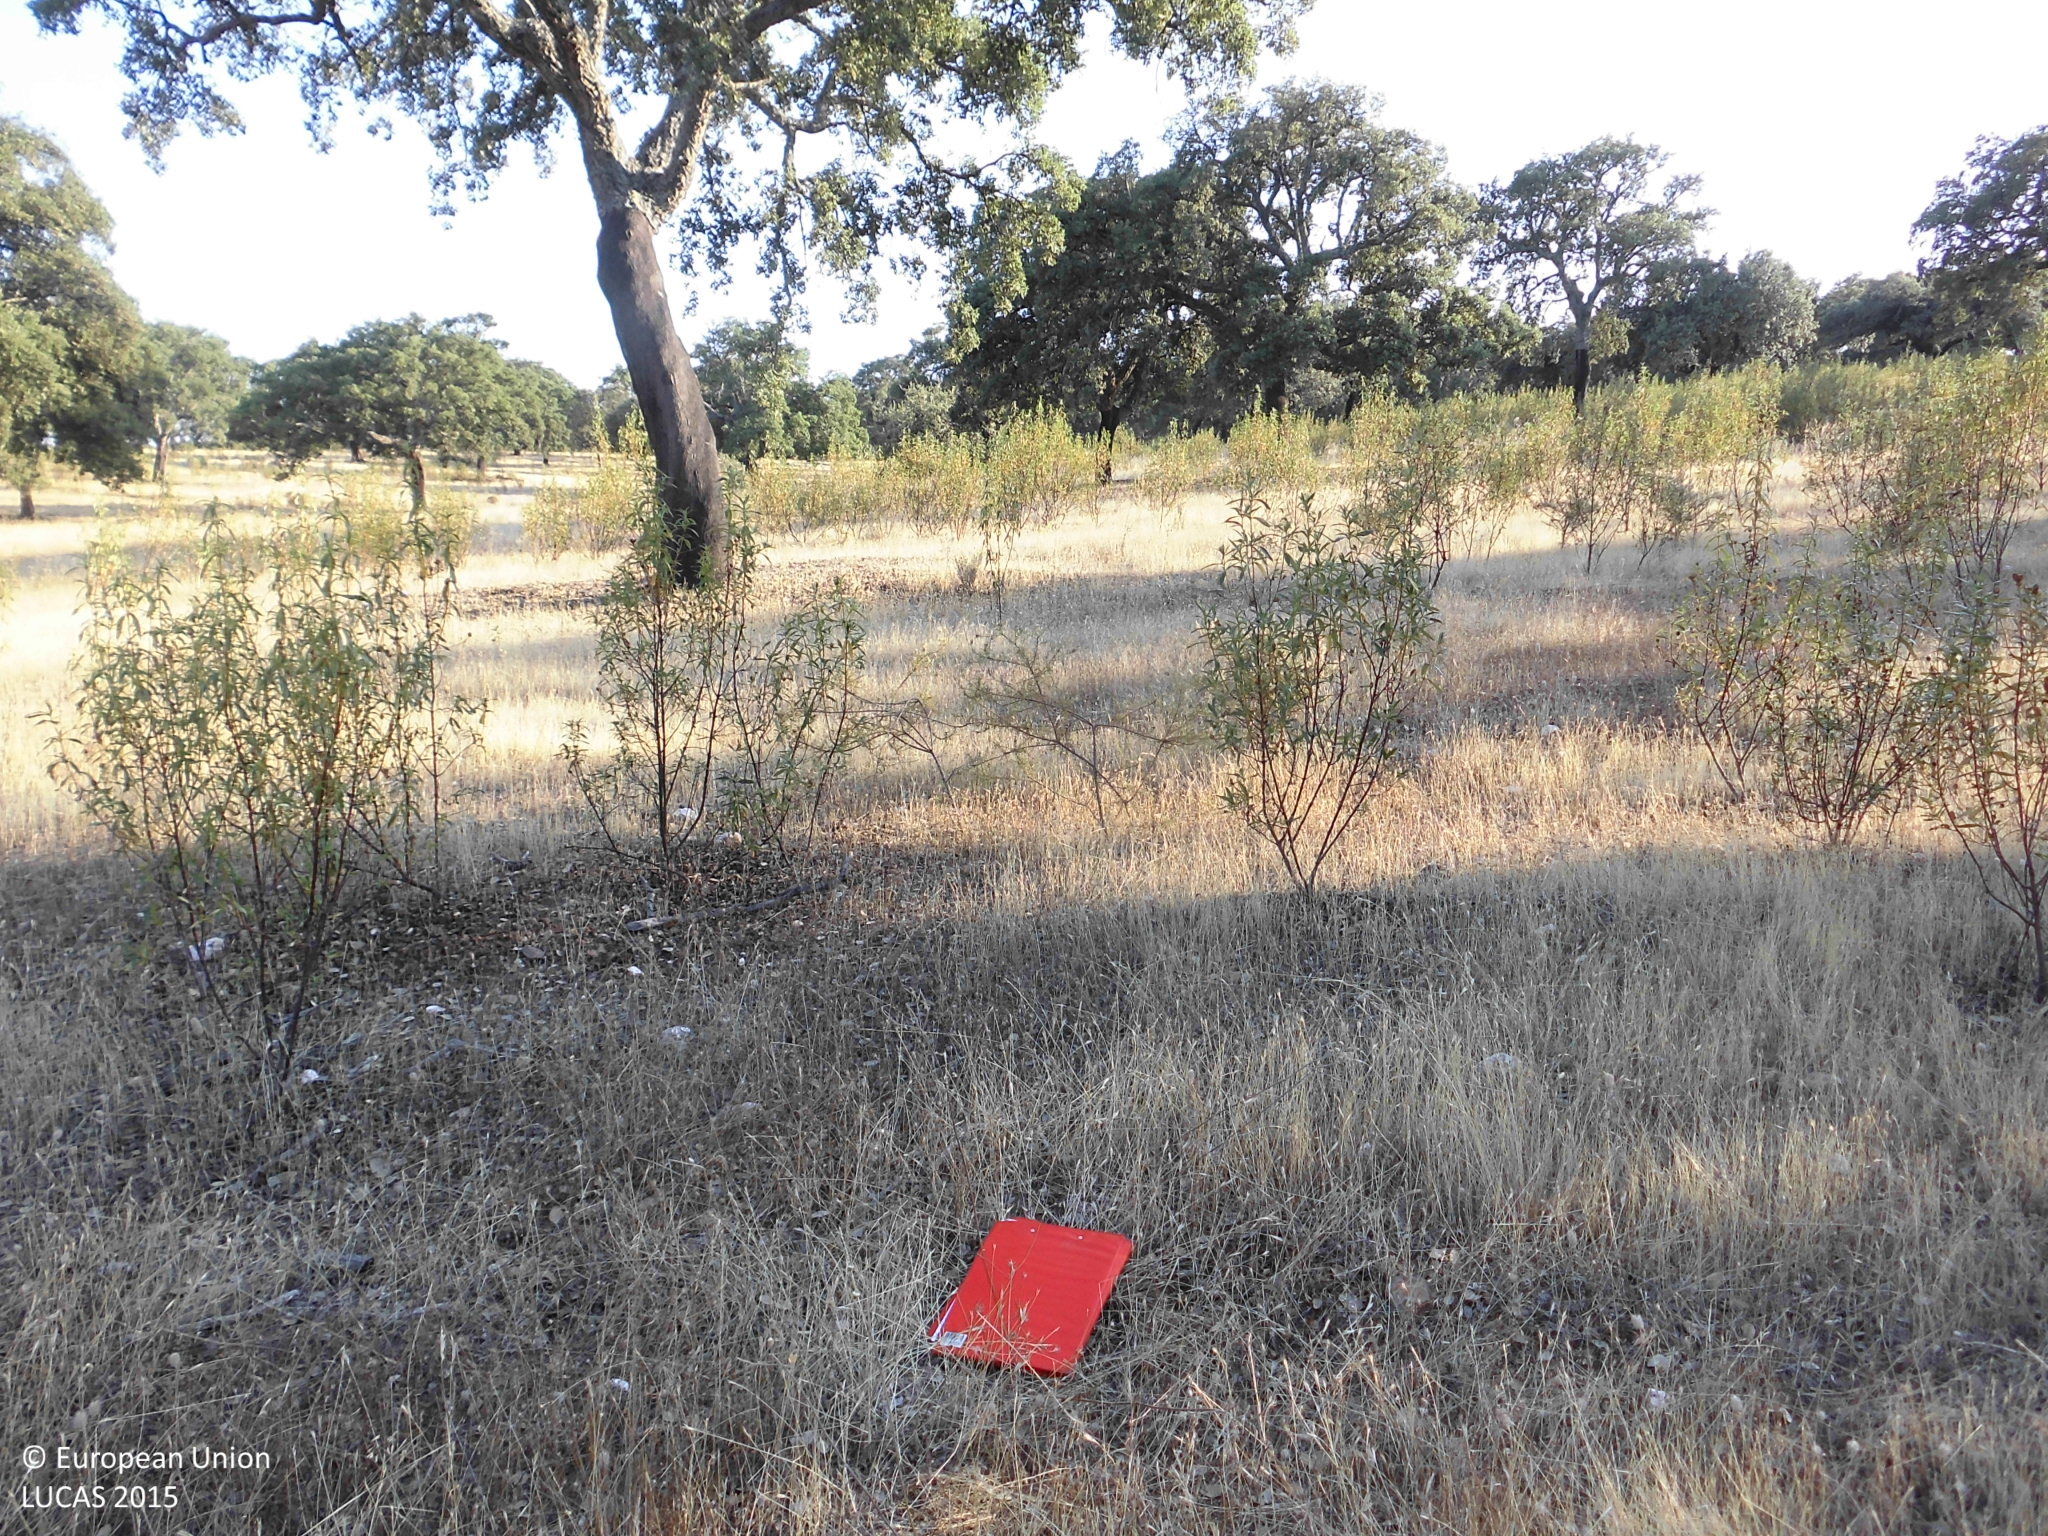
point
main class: Woodland
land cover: Broadleaved woodland
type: broadleaved evergreen forest
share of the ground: 10 - 25 %
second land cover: Grassland without tree/shrub cover
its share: > 75 %
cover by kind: herbaceous plants 60 %, broadleaved forest trees 30 %, shrubs 10 %
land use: Forestry
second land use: Agriculture (excluding fallow land and kitchen gardens)
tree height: > 5 m
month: June
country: ES
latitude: 39.9213
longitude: -5.9913
